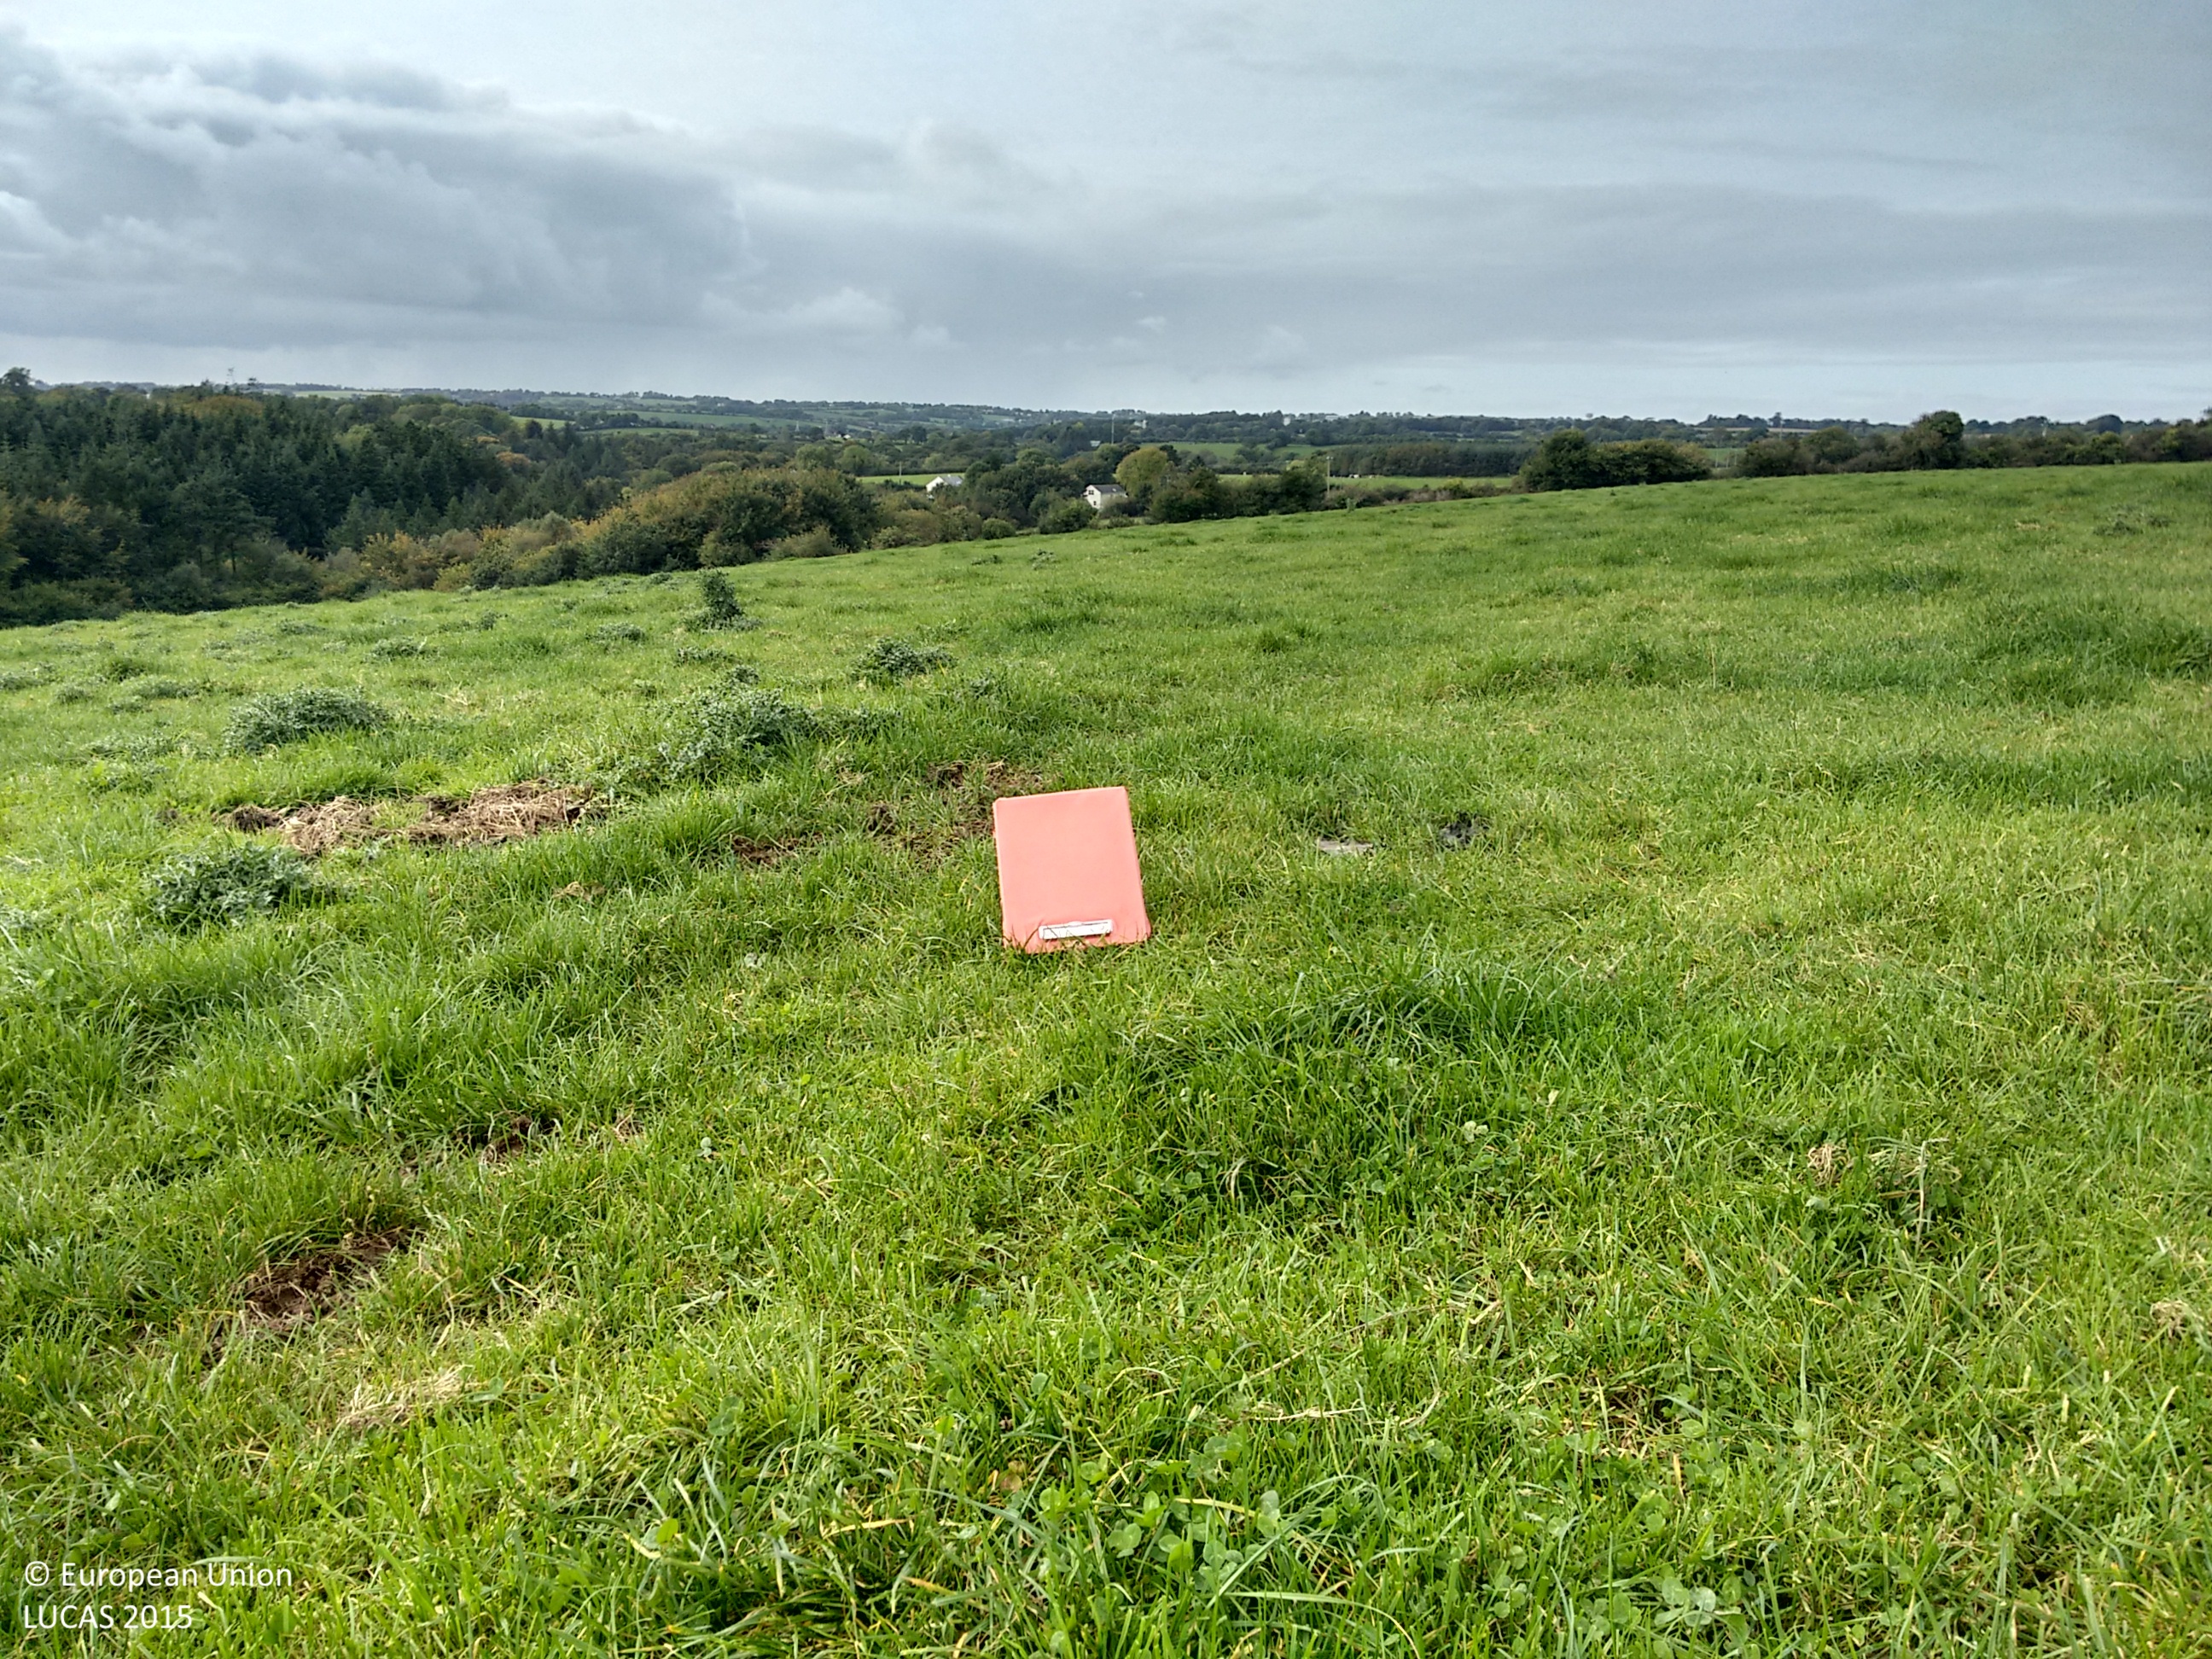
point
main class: Grassland
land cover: Grassland without tree/shrub cover
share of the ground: > 75 %
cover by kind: herbaceous plants 100 %
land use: Agriculture (excluding fallow land and kitchen gardens)
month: October
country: IE
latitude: 51.9602
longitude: -8.3657
